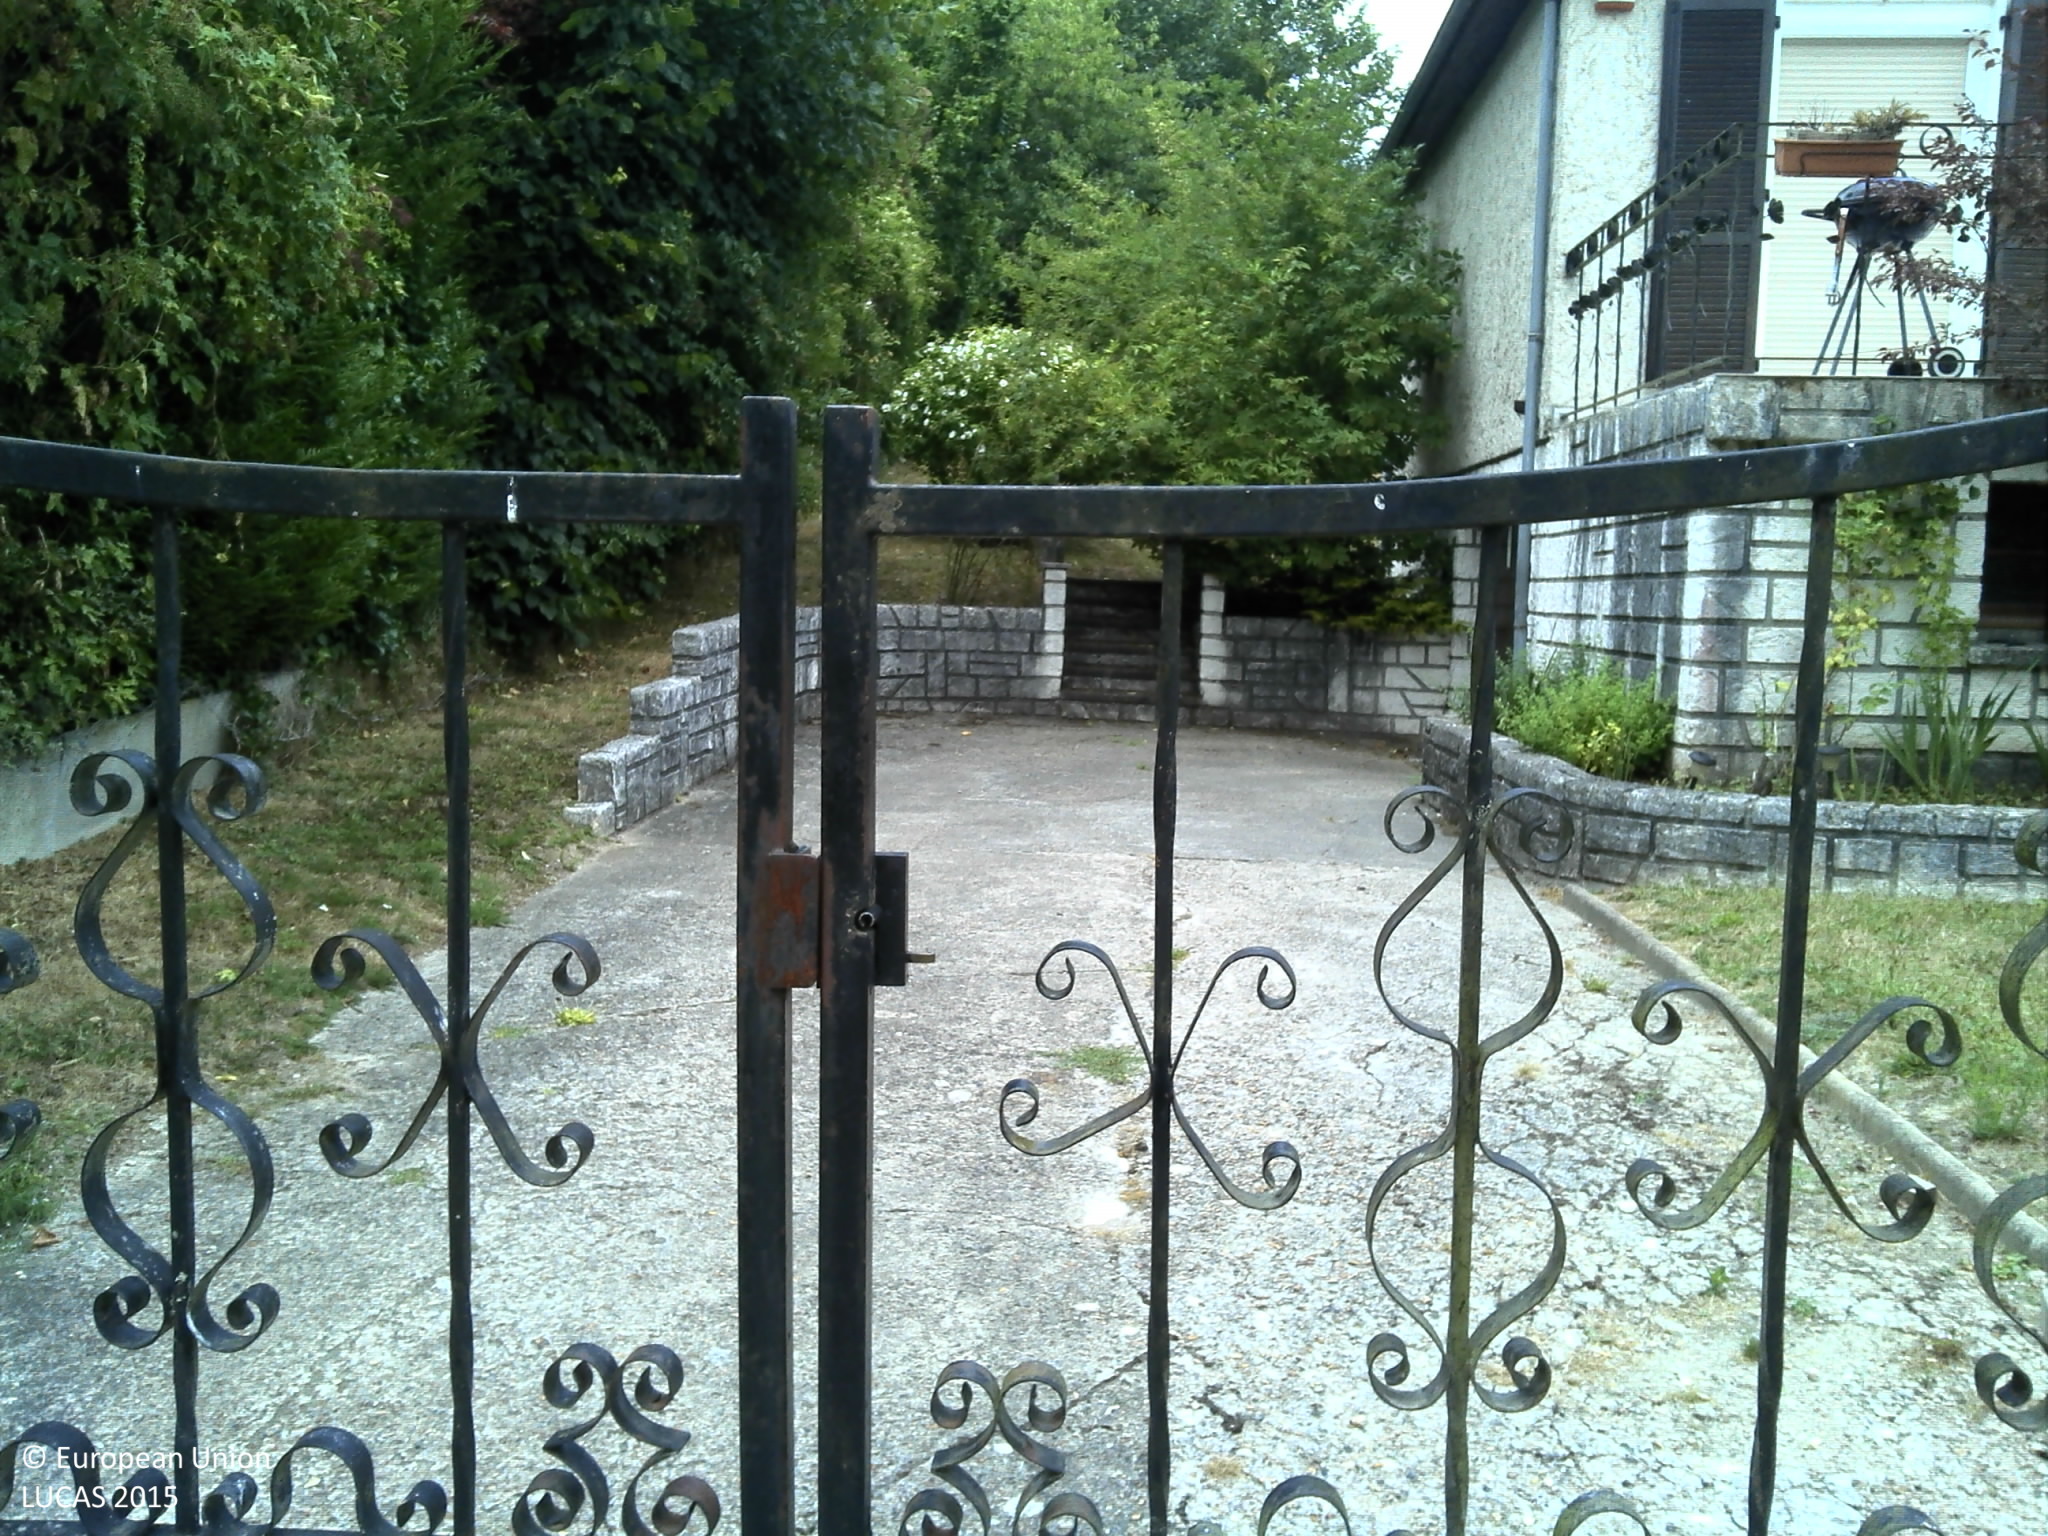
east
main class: Grassland
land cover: Grassland with sparse tree/shrub cover
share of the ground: > 75 %
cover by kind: herbaceous plants 95 %, broadleaved forest trees 5 %
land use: Residential
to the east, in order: Grassland with sparse tree/shrub cover; Artificial constructions in urban areas; Grassland without tree/shrub cover; Fences; Grass margins; Tracks; Rape and turnip rape
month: July
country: FR
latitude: 48.8635
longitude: 1.8742
